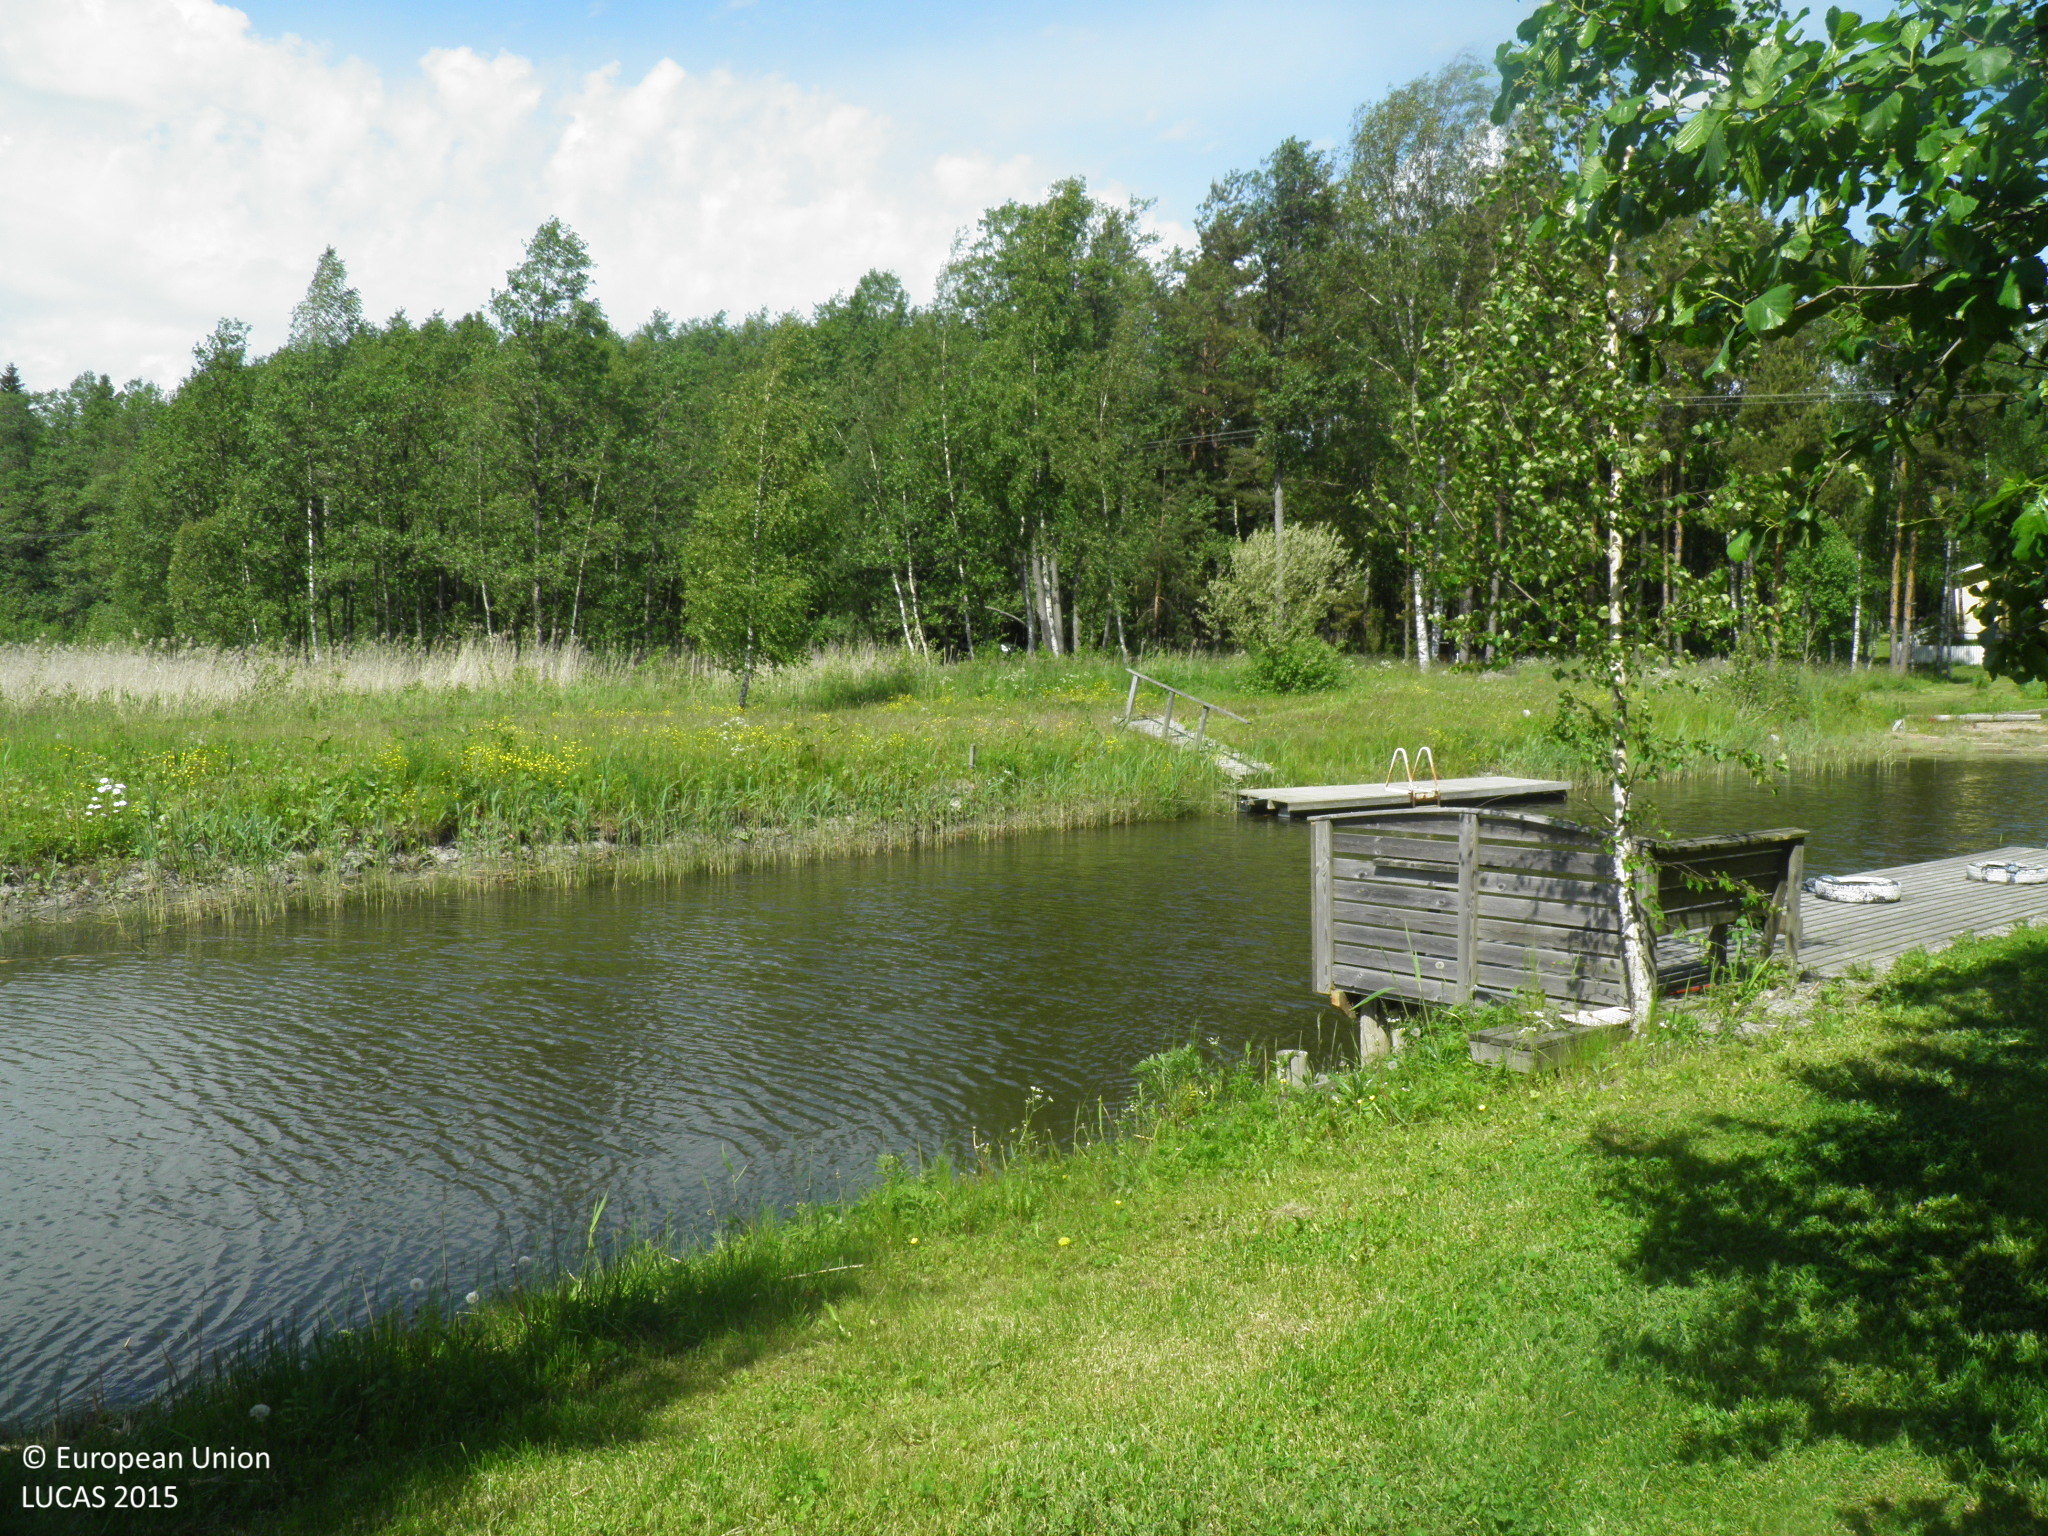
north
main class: Woodland
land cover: Broadleaved woodland
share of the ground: 50 - 75 %
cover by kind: broadleaved forest trees 55 %, herbaceous plants 45 %
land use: Amenities, museums, leisure
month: June
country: FI
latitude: 60.5567
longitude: 21.8235
